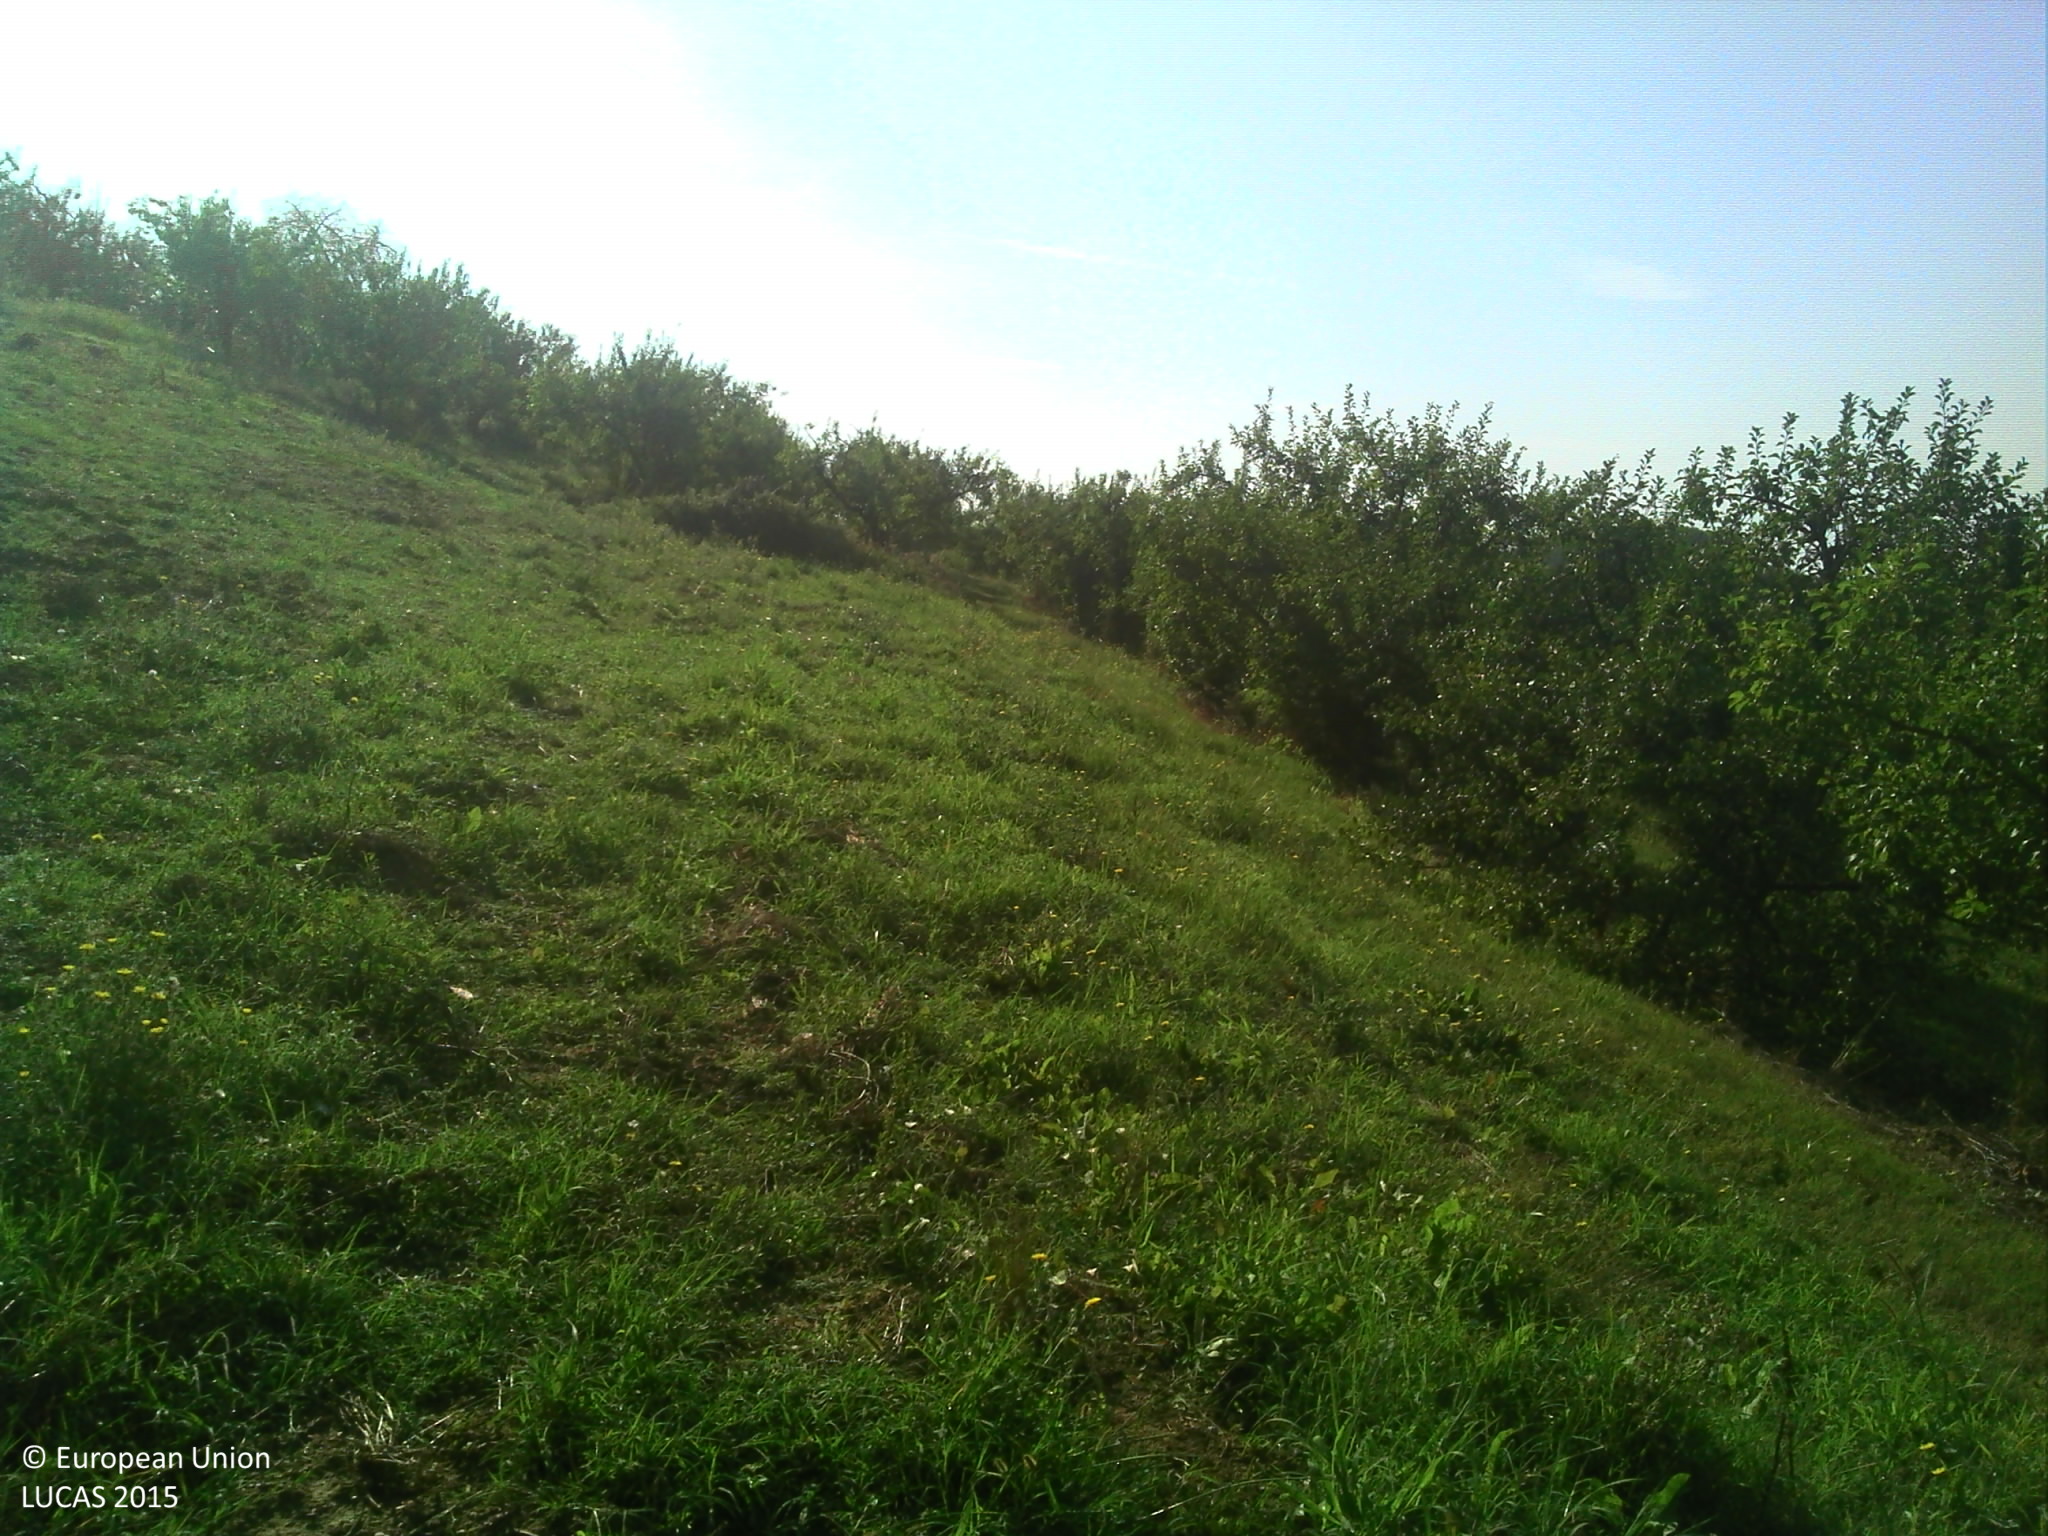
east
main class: Grassland
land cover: Grassland without tree/shrub cover
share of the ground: > 75 %
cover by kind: herbaceous plants 100 %
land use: Agriculture (excluding fallow land and kitchen gardens)
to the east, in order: Grassland without tree/shrub cover; Cherry fruit; Tracks; Other fruit trees and berries; Electric lines; Tracks; Other fruit trees and berries; Grassland without tree/shrub cover; Vineyards
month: August
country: FR
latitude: 44.0970
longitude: 1.3430
